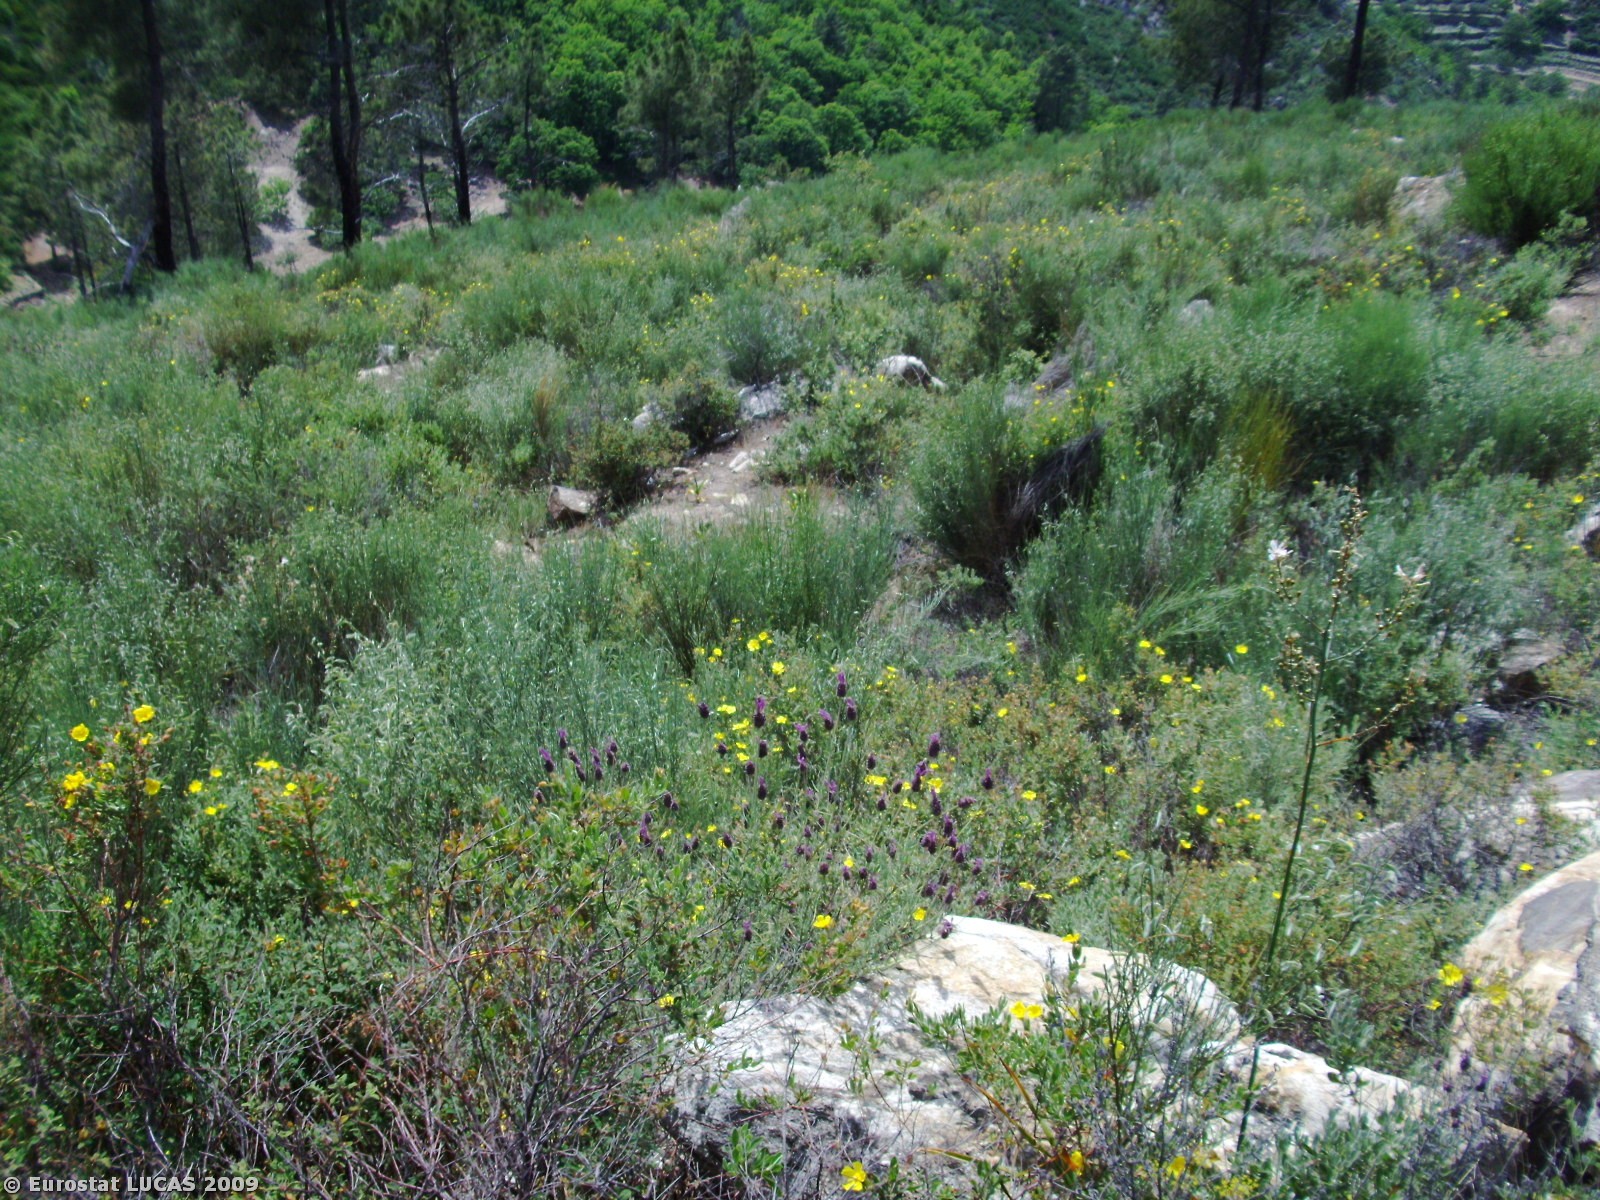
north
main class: Shrubland
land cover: Shrubland with sparse tree cover
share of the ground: > 75 %
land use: Unused
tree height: > 5 m
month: May
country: PT
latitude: 41.0819
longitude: -7.4871
